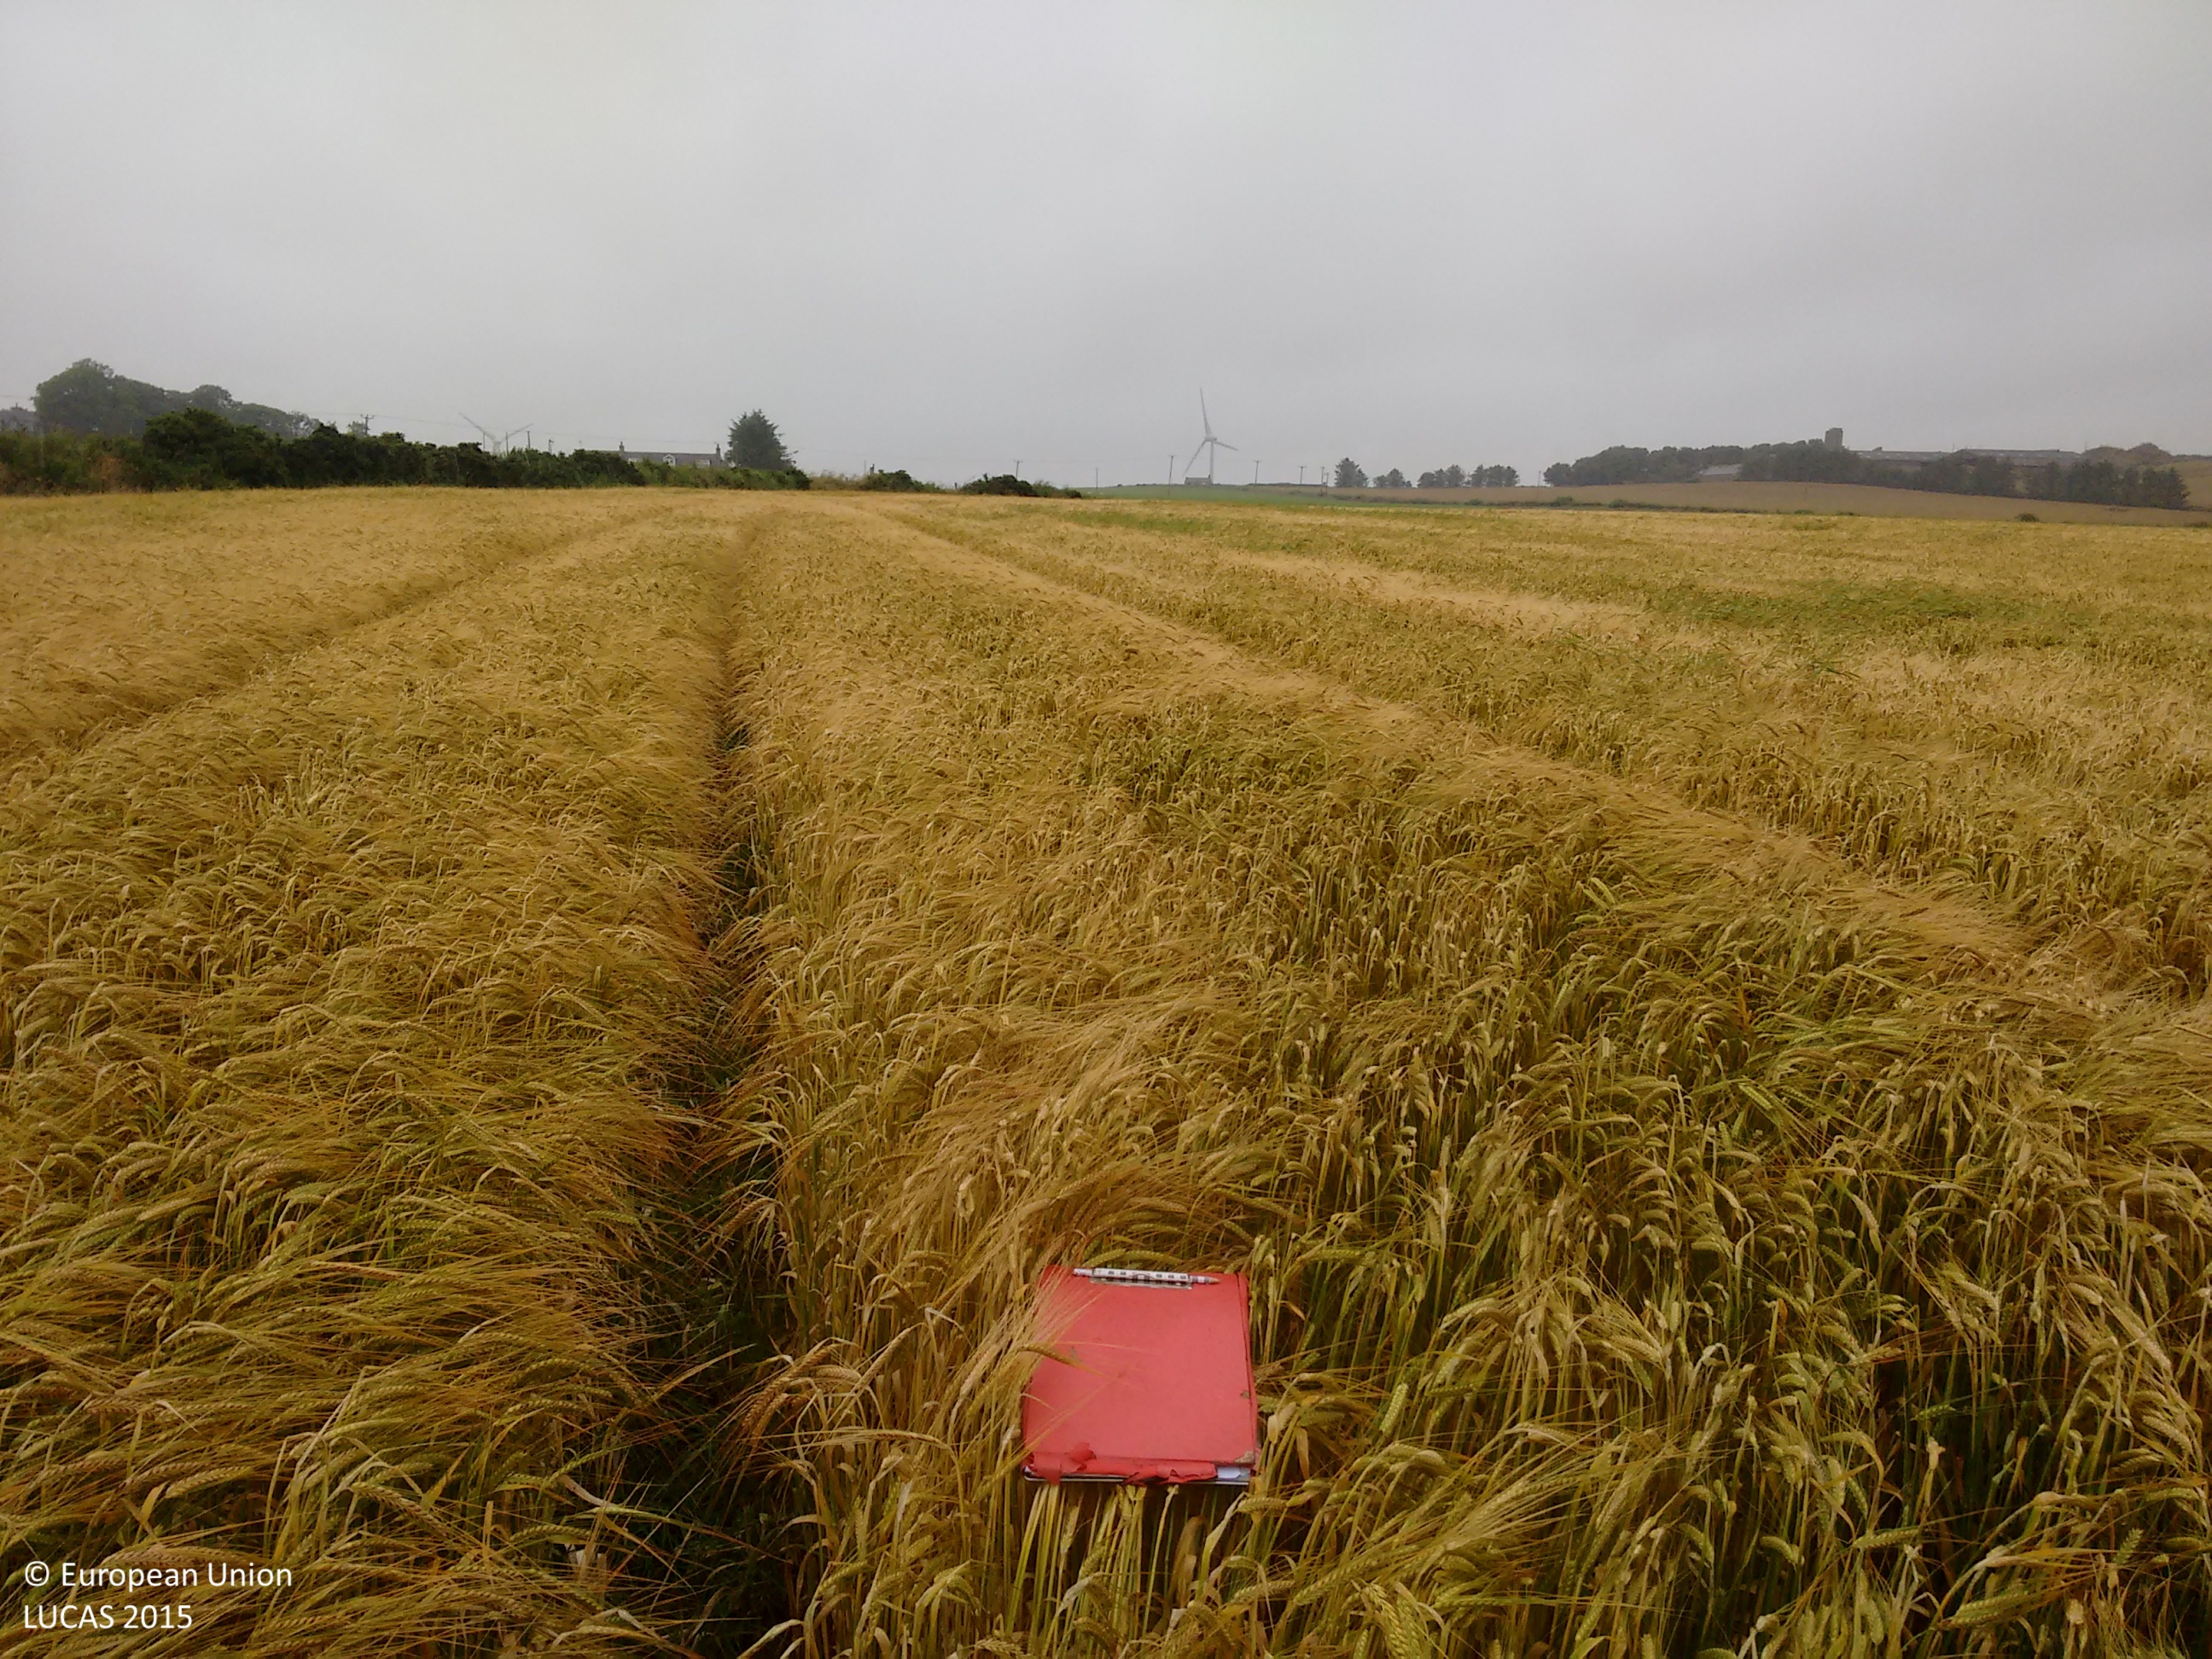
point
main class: Cropland
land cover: Barley
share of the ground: > 75 %
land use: Agriculture (excluding fallow land and kitchen gardens)
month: August
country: GB
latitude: 57.3047
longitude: -2.1149
